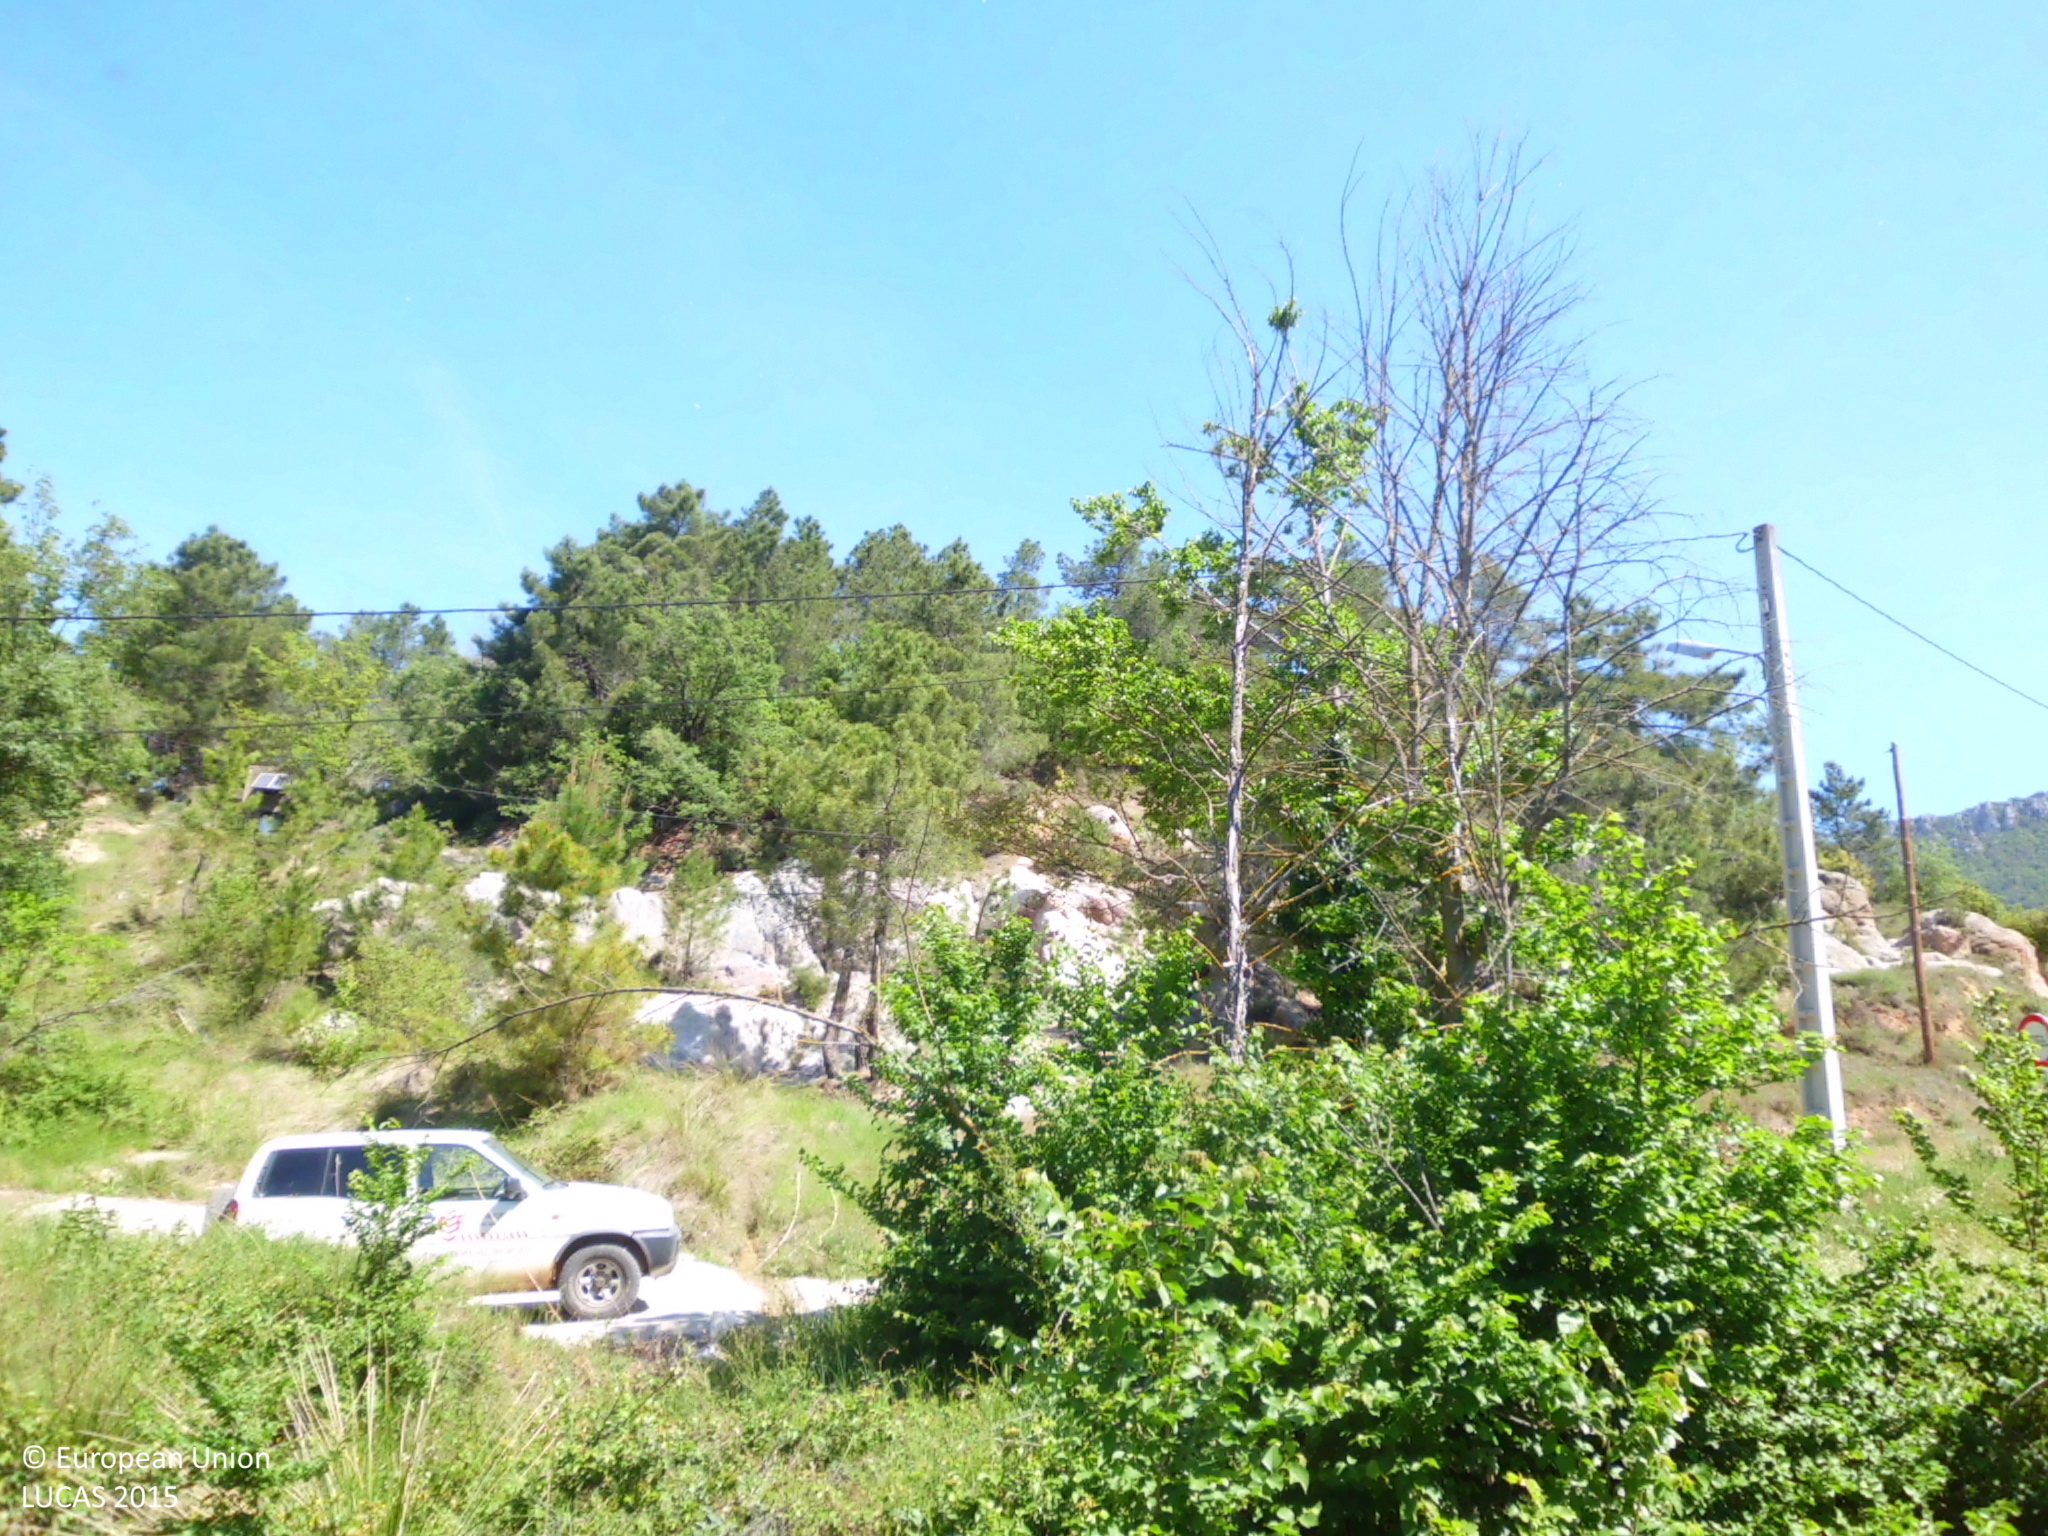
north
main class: Woodland
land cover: Other mixed woodland
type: acidophilous oak and oak-birch forest
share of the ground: > 75 %
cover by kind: broadleaved forest trees 60 %, coniferous forest trees 20 %, shrubs 20 %
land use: Semi-natural and natural areas not in use
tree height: > 5 m
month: May
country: ES
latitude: 42.7058
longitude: -3.4288
